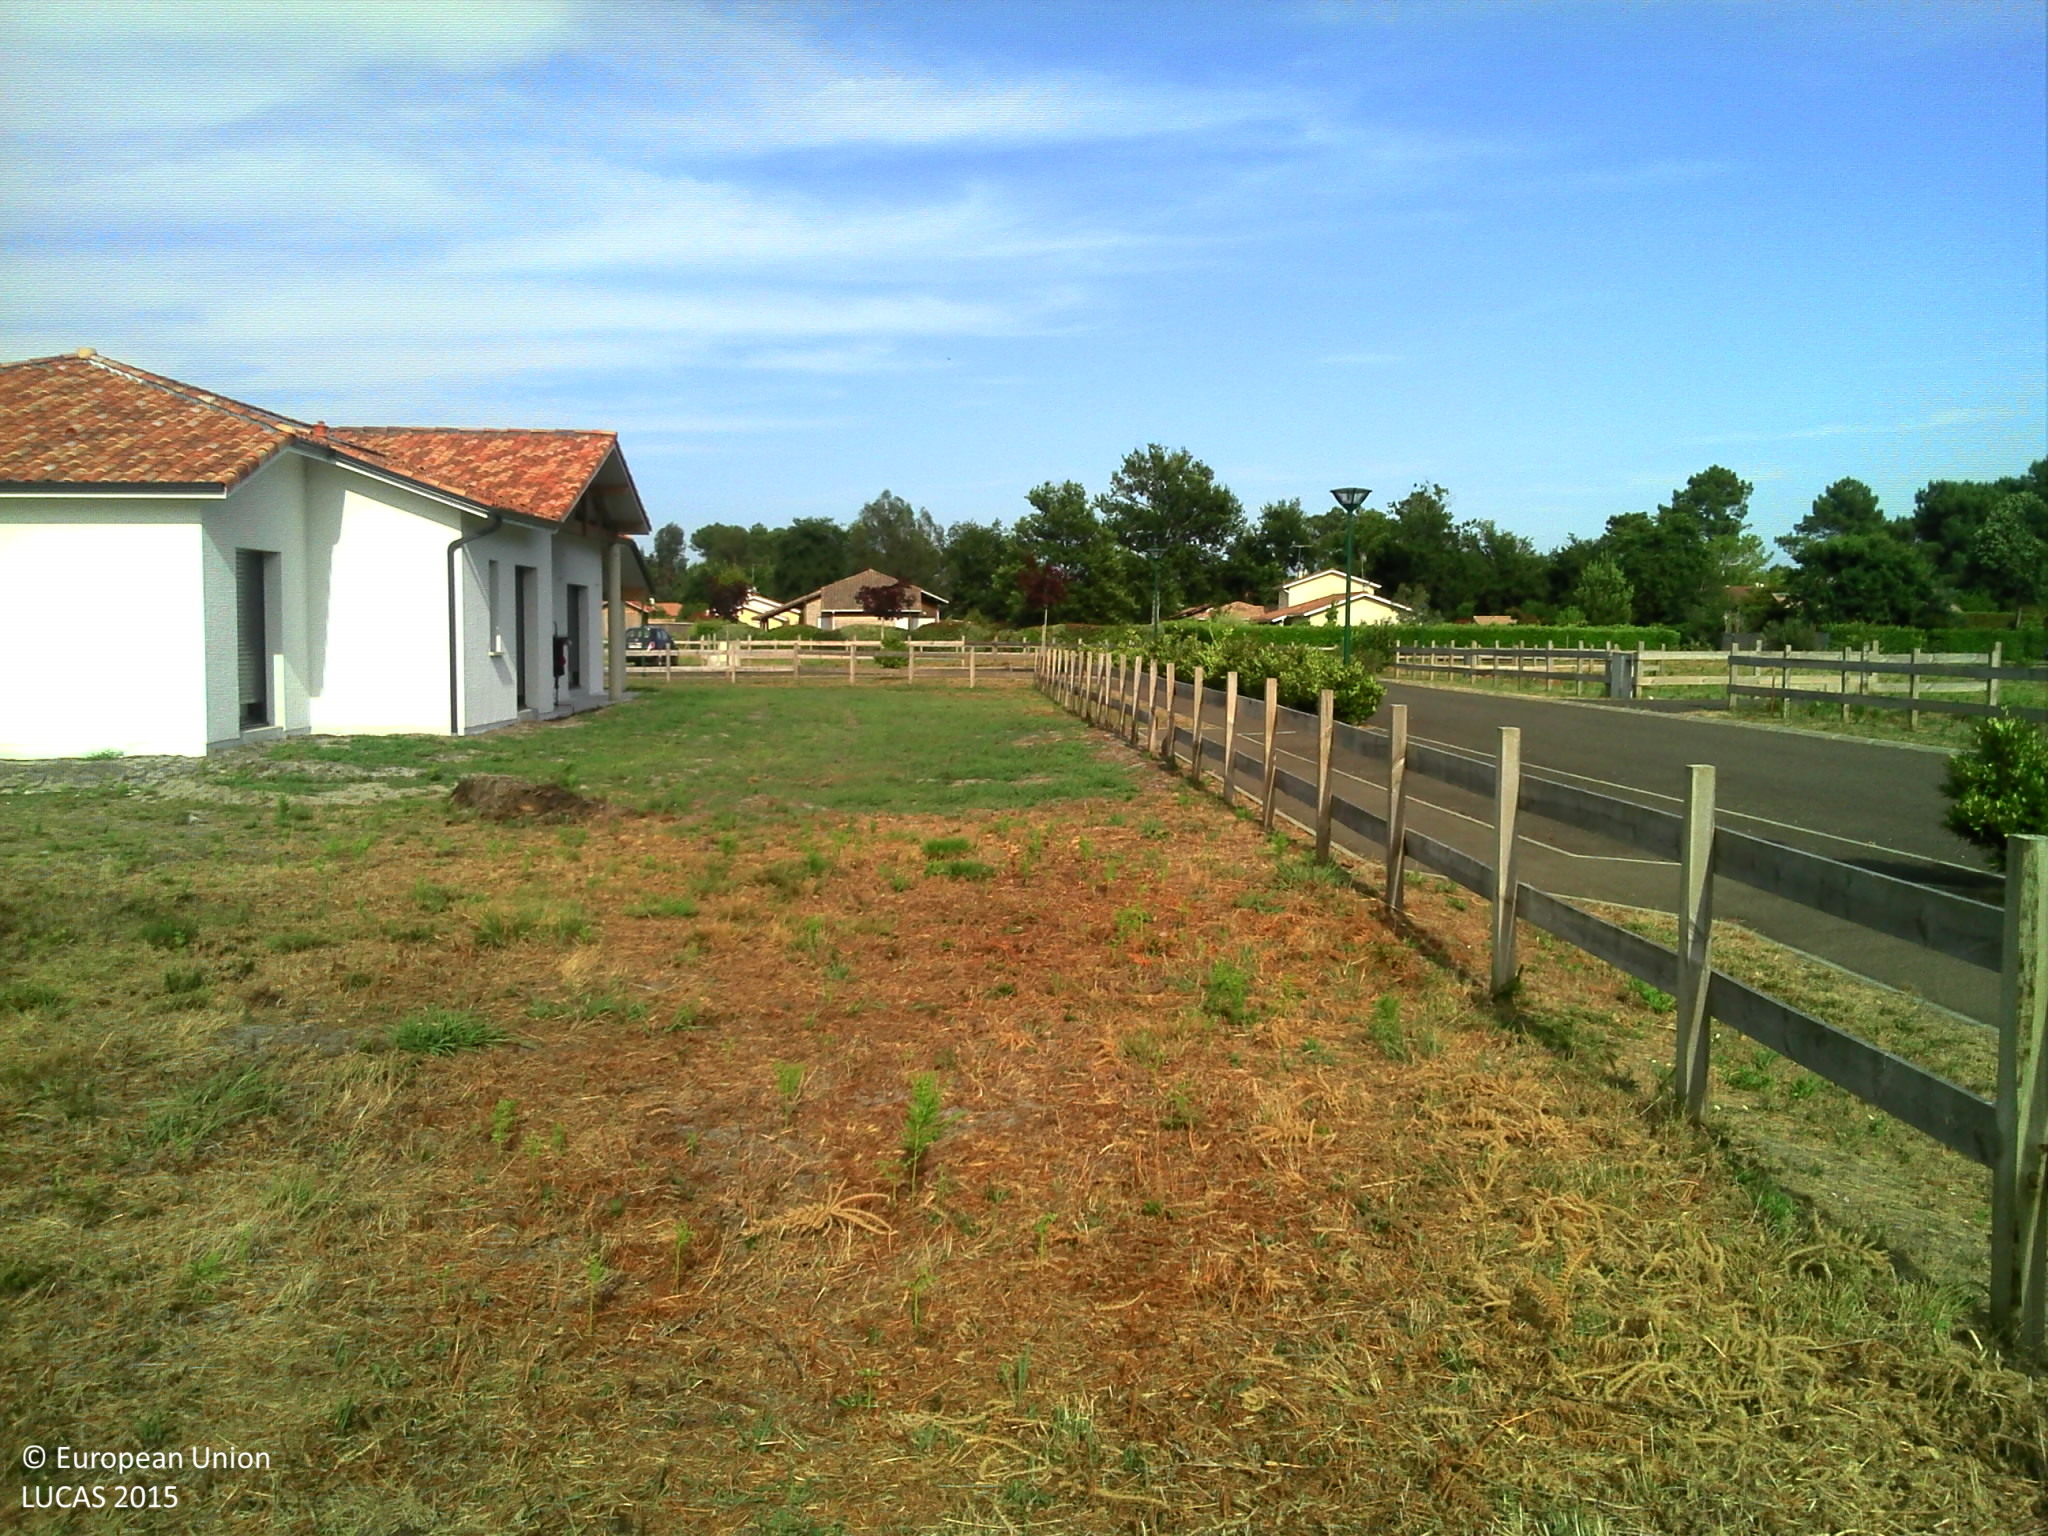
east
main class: Grassland
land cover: Grassland without tree/shrub cover
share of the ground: > 75 %
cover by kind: herbaceous plants 100 %
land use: Residential
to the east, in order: Grassland without tree/shrub cover; Artificial constructions in urban areas
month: July
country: FR
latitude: 43.9117
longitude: -1.3141
